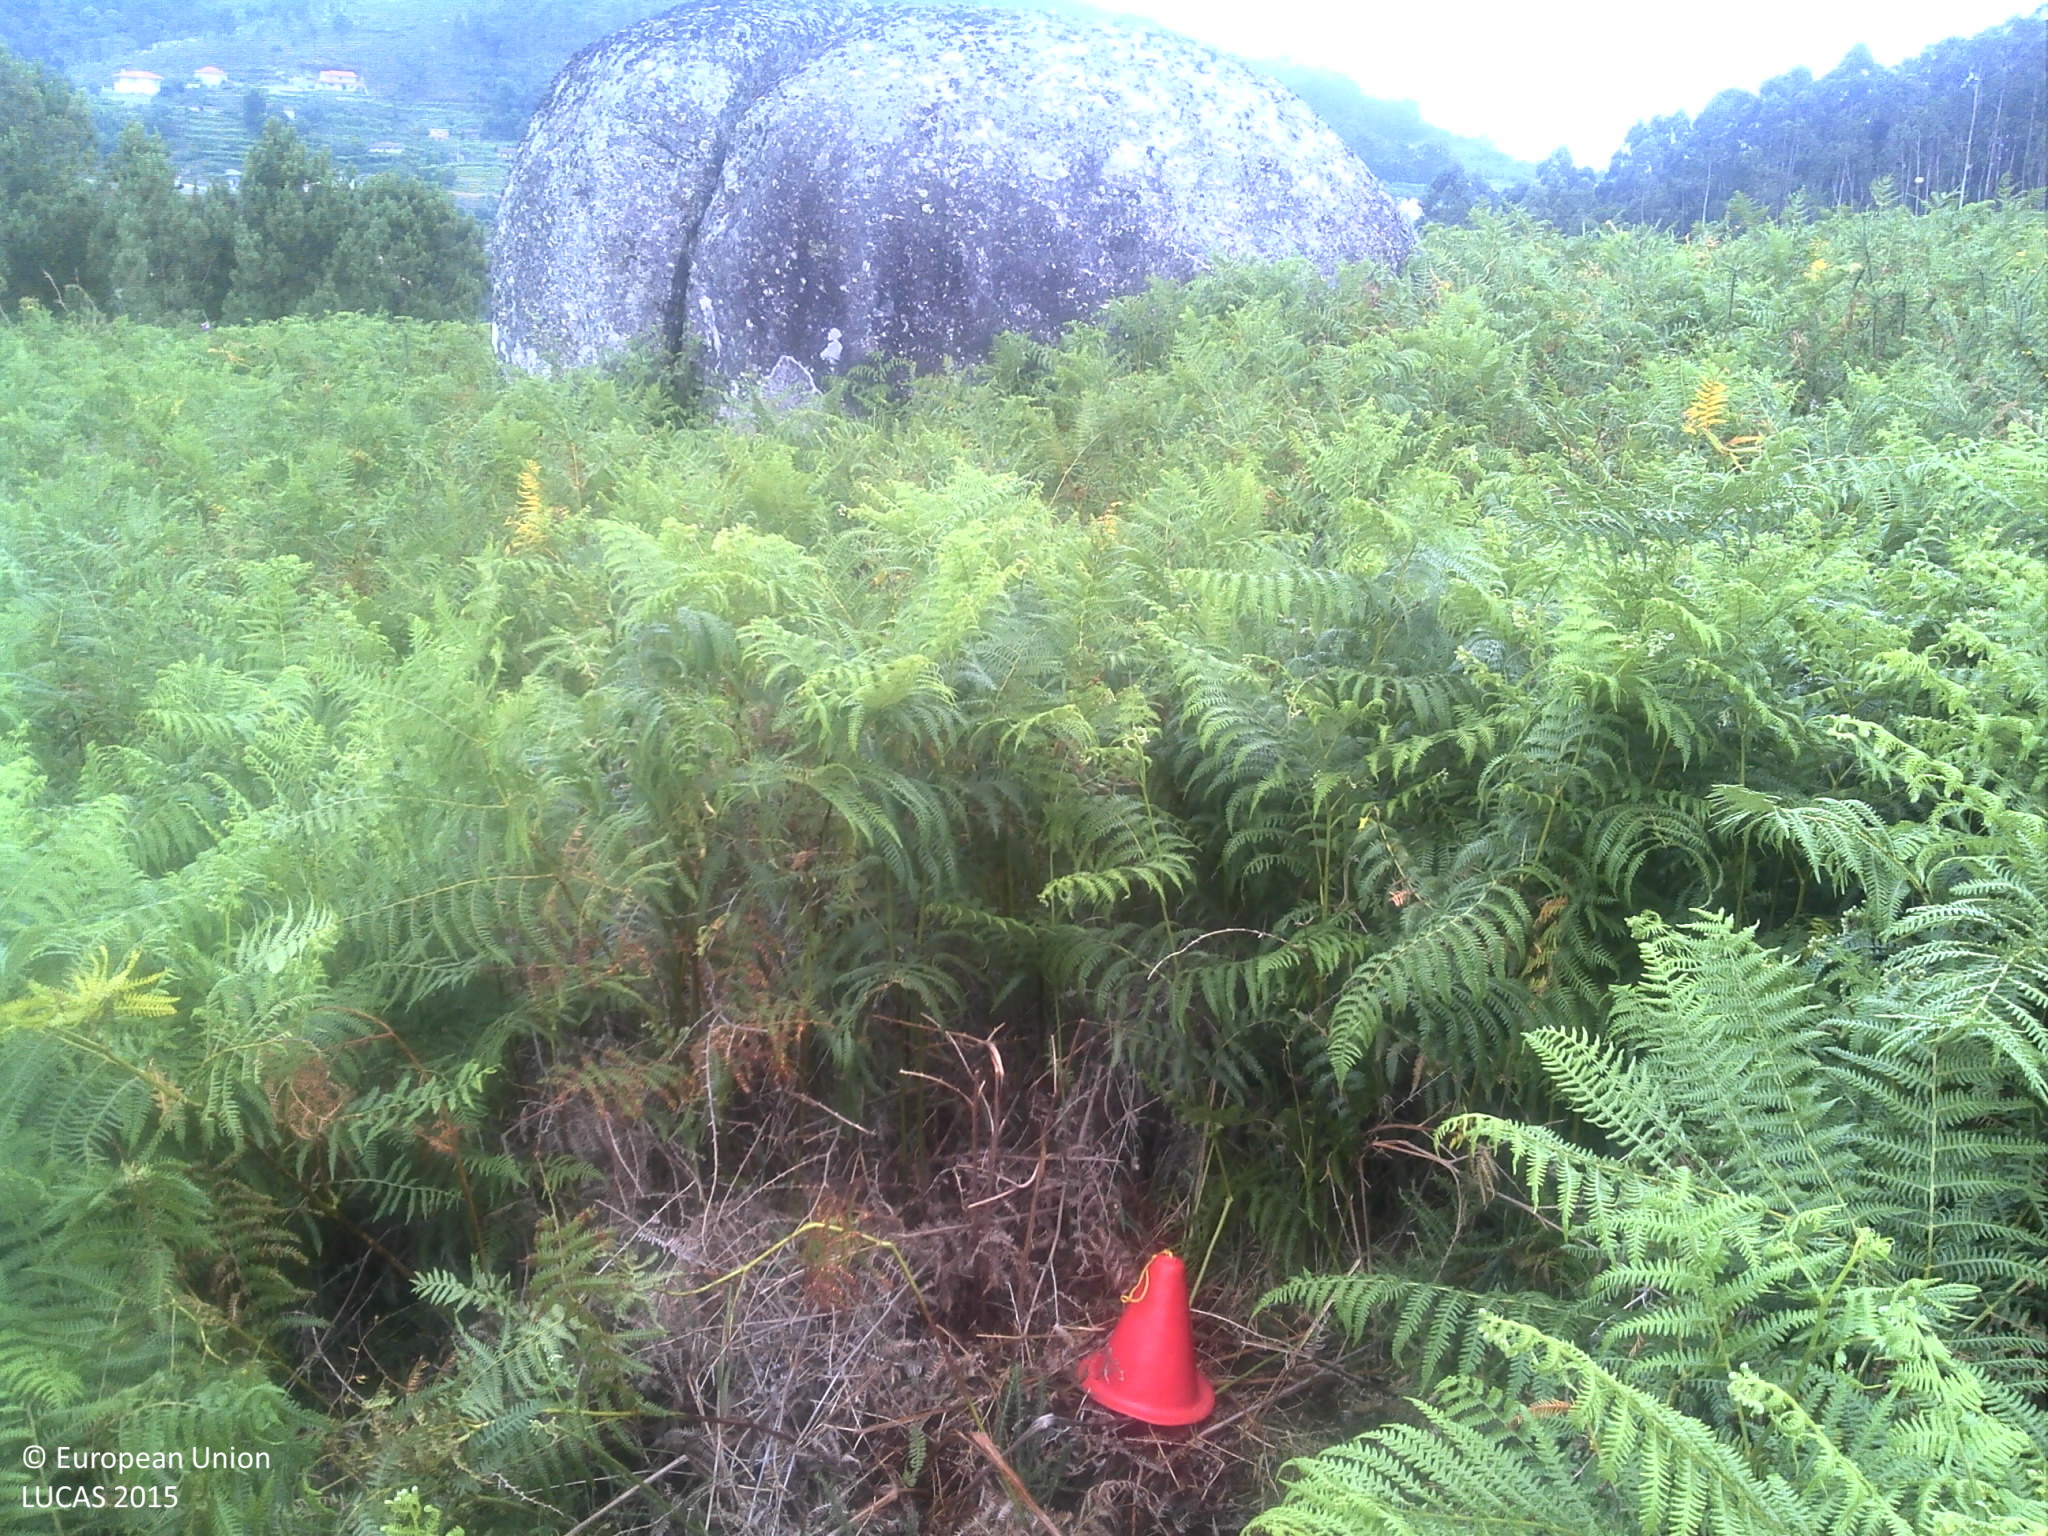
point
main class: Shrubland
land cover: Shrubland without tree cover
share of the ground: > 75 %
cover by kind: shrubs 90 %, herbaceous plants 10 %
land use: Semi-natural and natural areas not in use
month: June
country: PT
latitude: 41.7109
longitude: -8.3875
